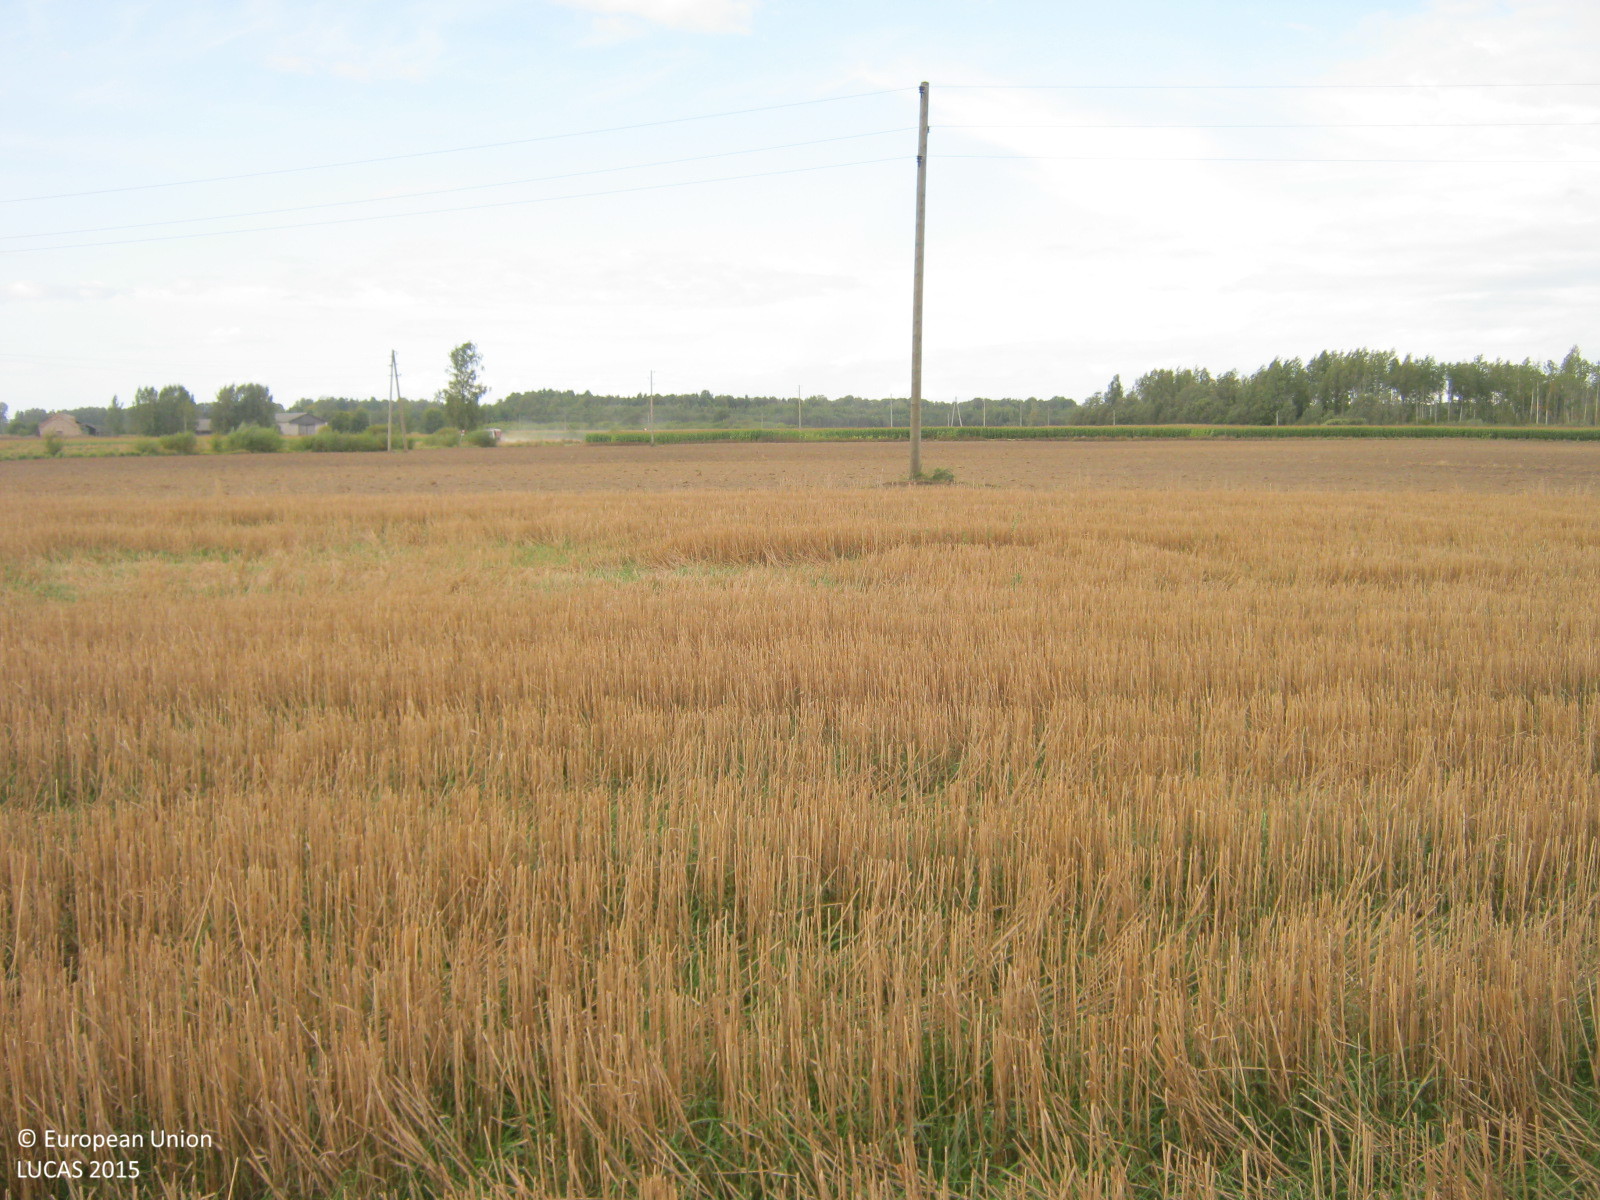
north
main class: Cropland
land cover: Common wheat
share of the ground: 50 - 75 %
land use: Agriculture (excluding fallow land and kitchen gardens)
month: September
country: LV
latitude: 57.3463
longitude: 24.5671
